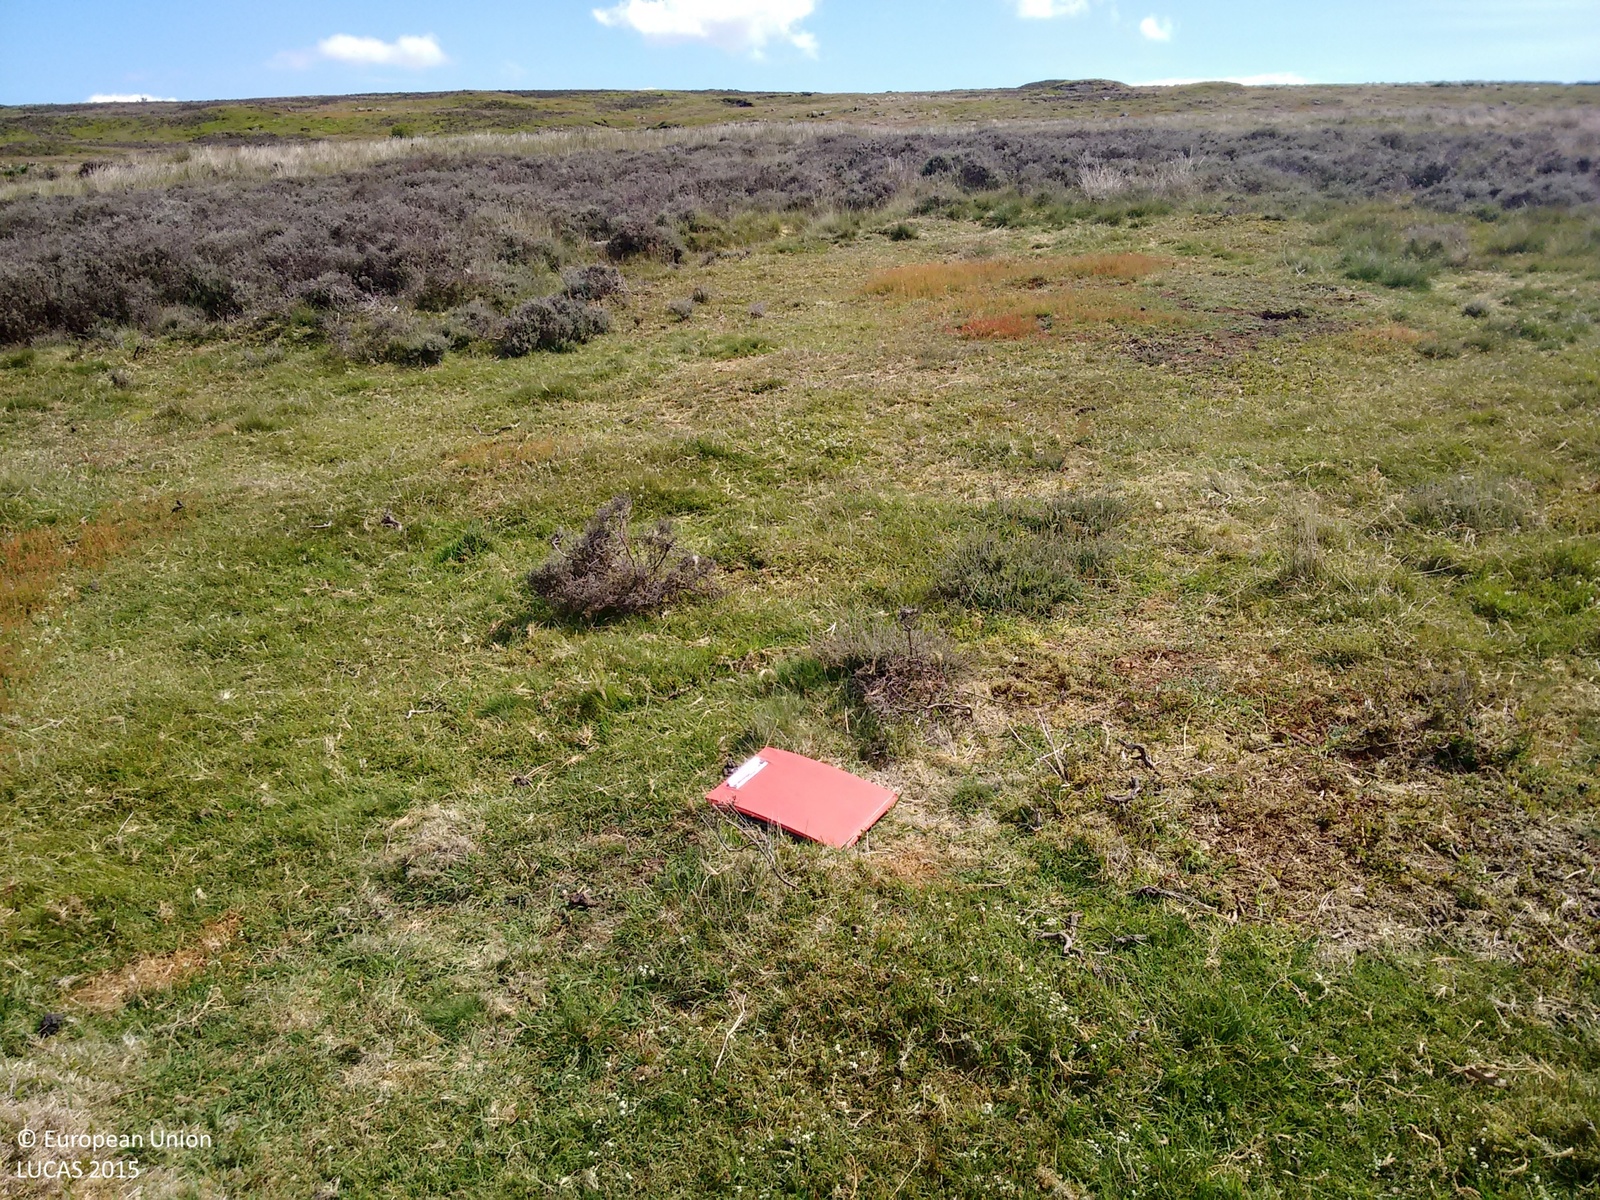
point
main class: Shrubland
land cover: Shrubland without tree cover
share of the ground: > 75 %
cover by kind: shrubs 60 %, herbaceous plants 40 %
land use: Agriculture (excluding fallow land and kitchen gardens)
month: July
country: GB
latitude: 54.4703
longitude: -0.8878
